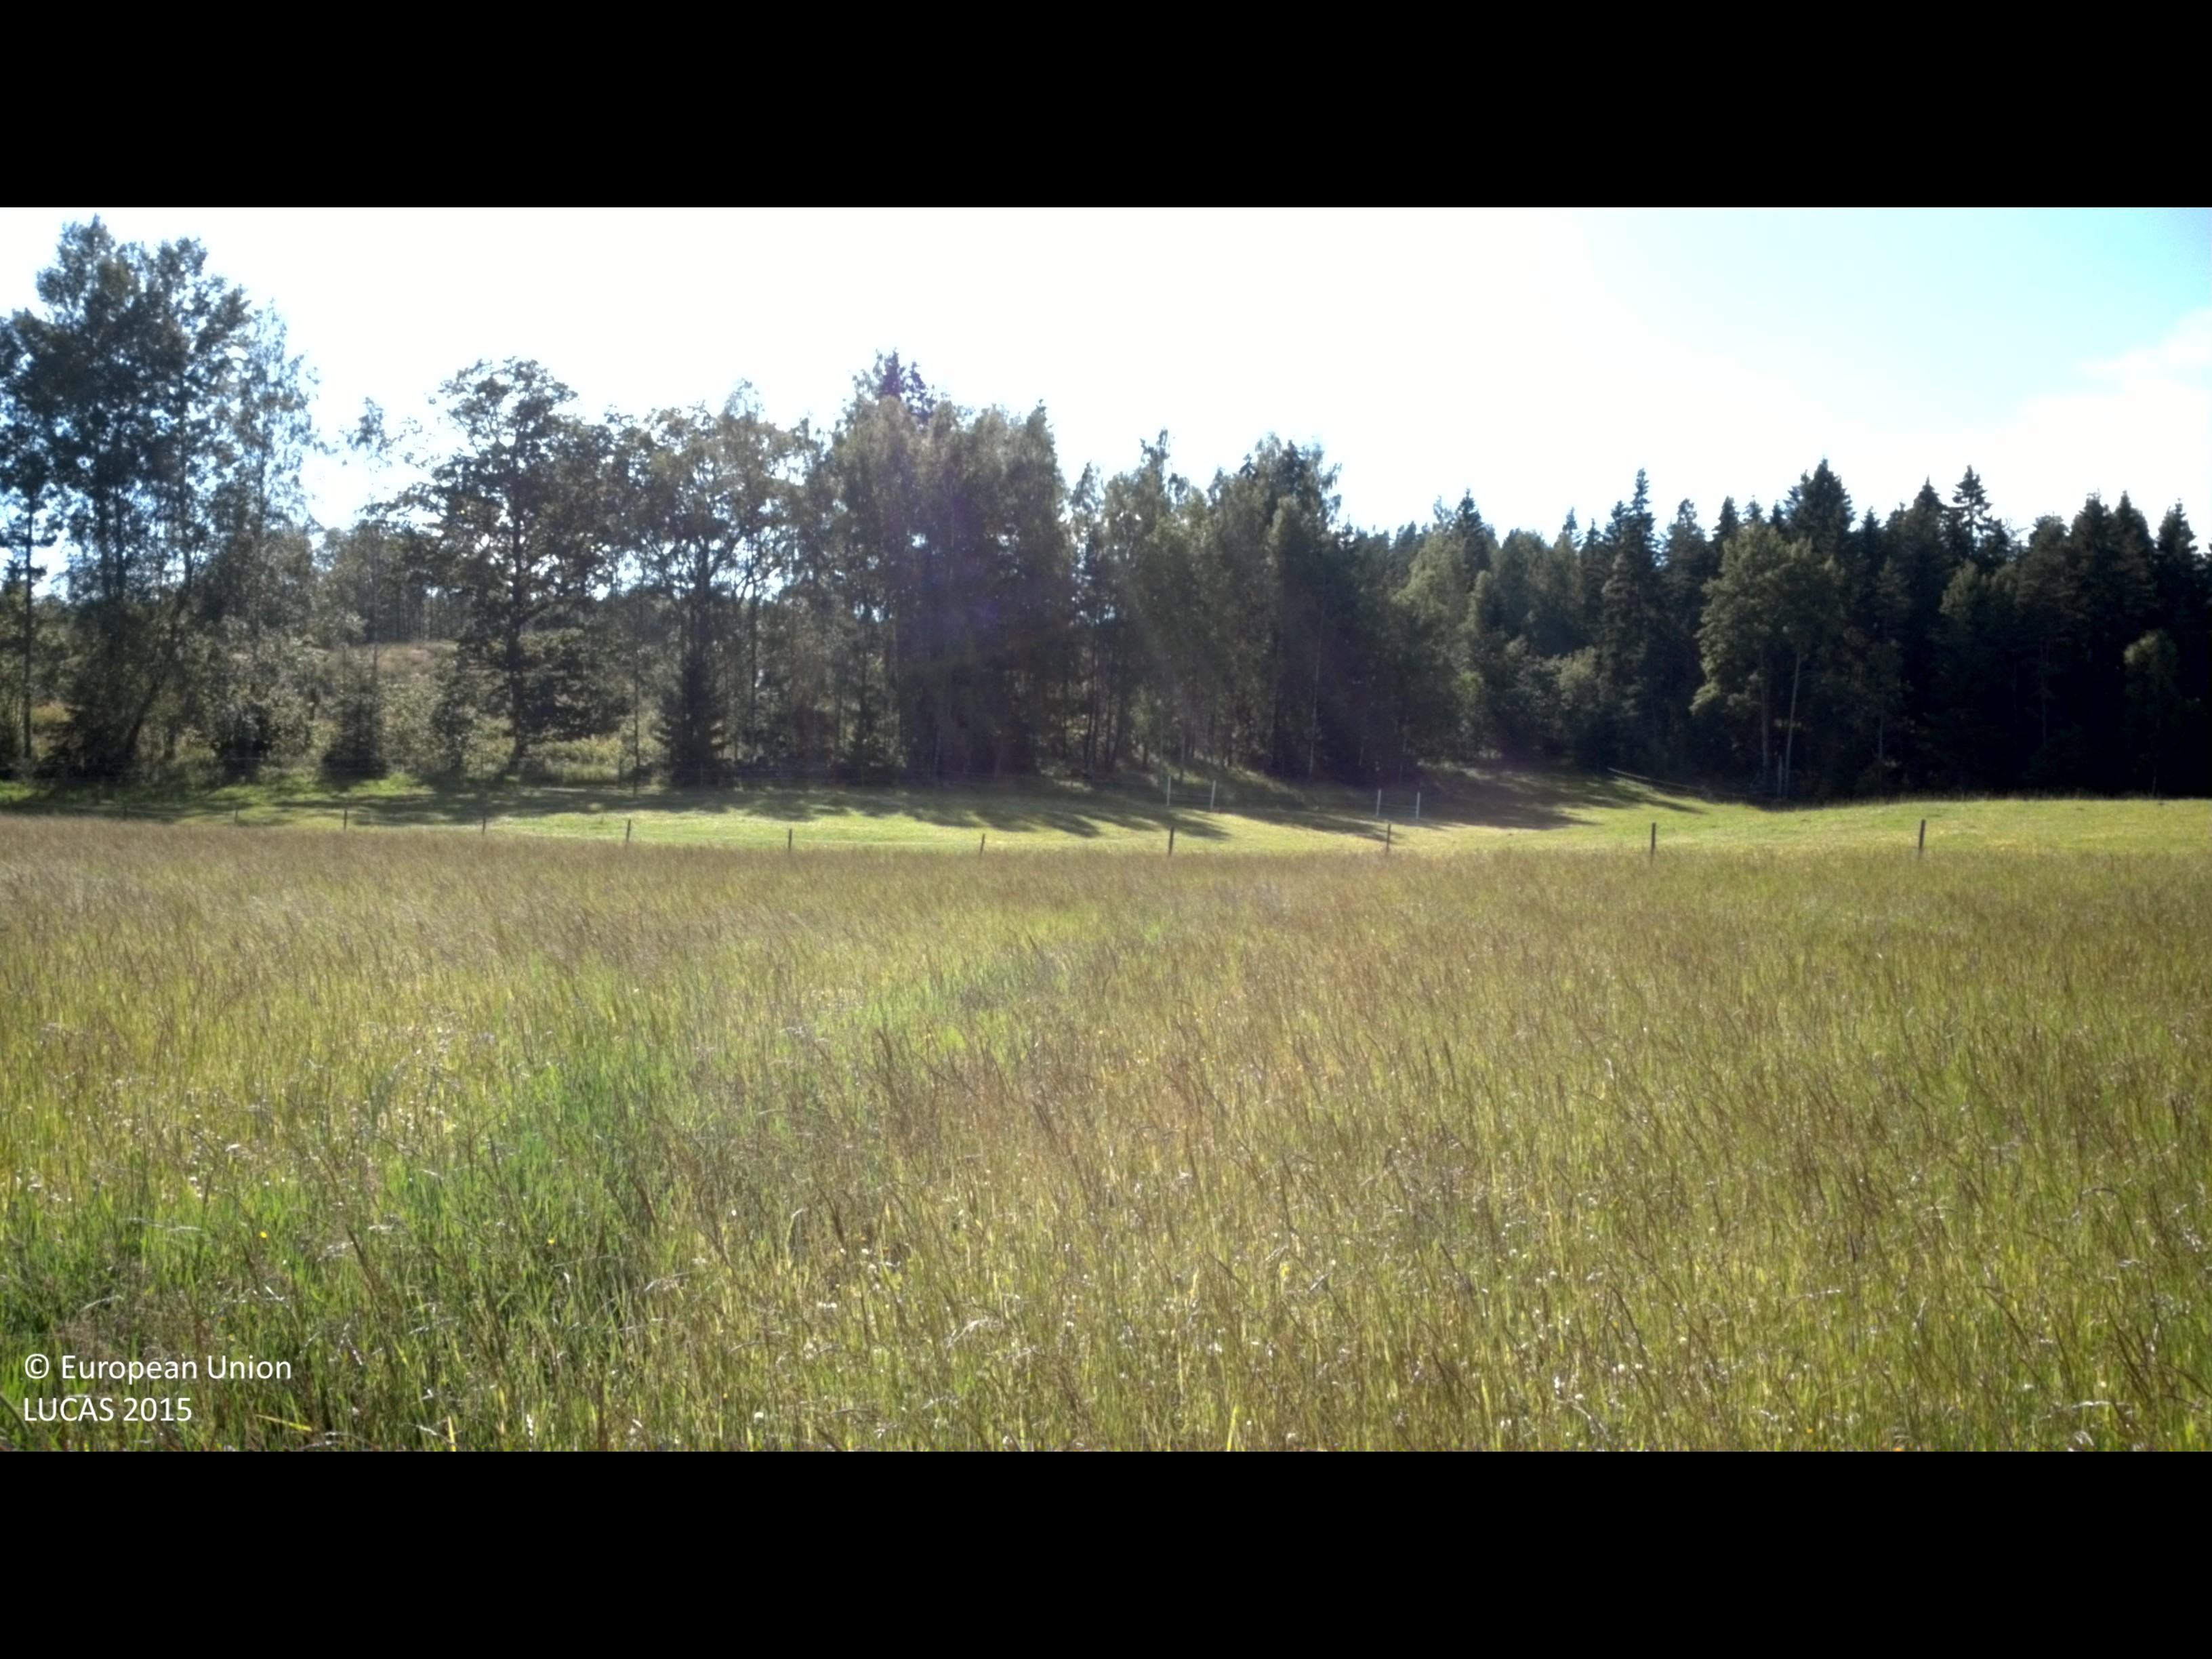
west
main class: Cropland
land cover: Other leguminous and mixtures for fodder
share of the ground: > 75 %
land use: Agriculture (excluding fallow land and kitchen gardens)
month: June
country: SE
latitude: 58.2235
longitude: 16.1423
